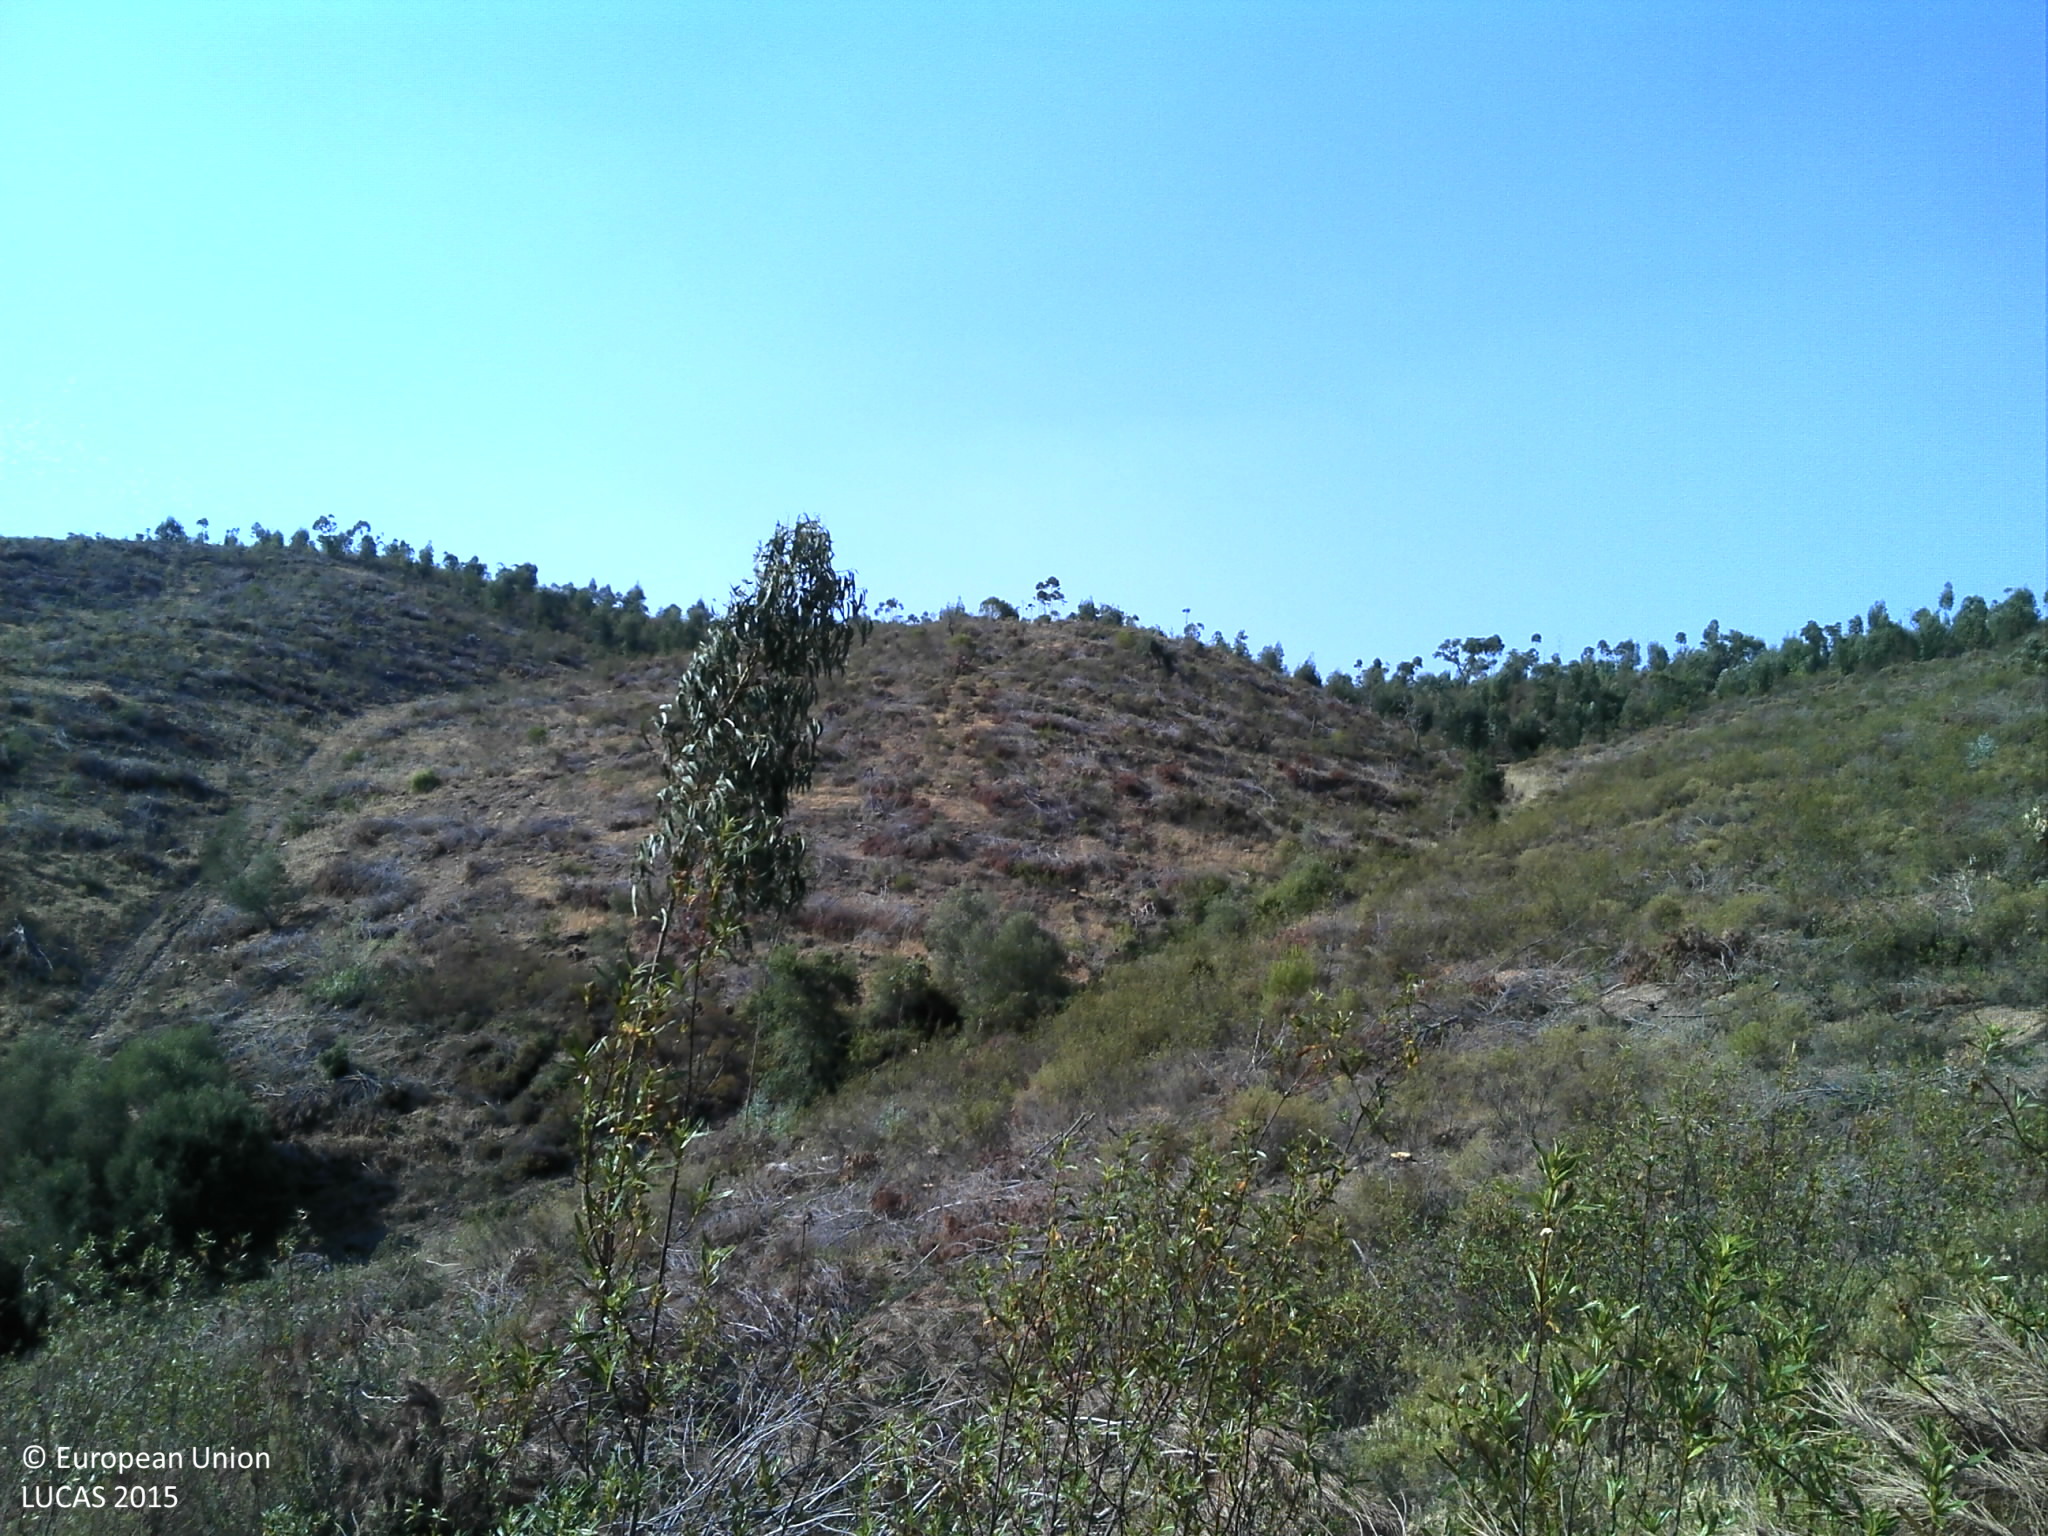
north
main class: Shrubland
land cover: Shrubland without tree cover
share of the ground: > 75 %
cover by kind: shrubs 90 %, herbaceous plants 10 %
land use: Forestry
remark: Clear cut
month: June
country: PT
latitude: 38.3152
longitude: -7.6767
